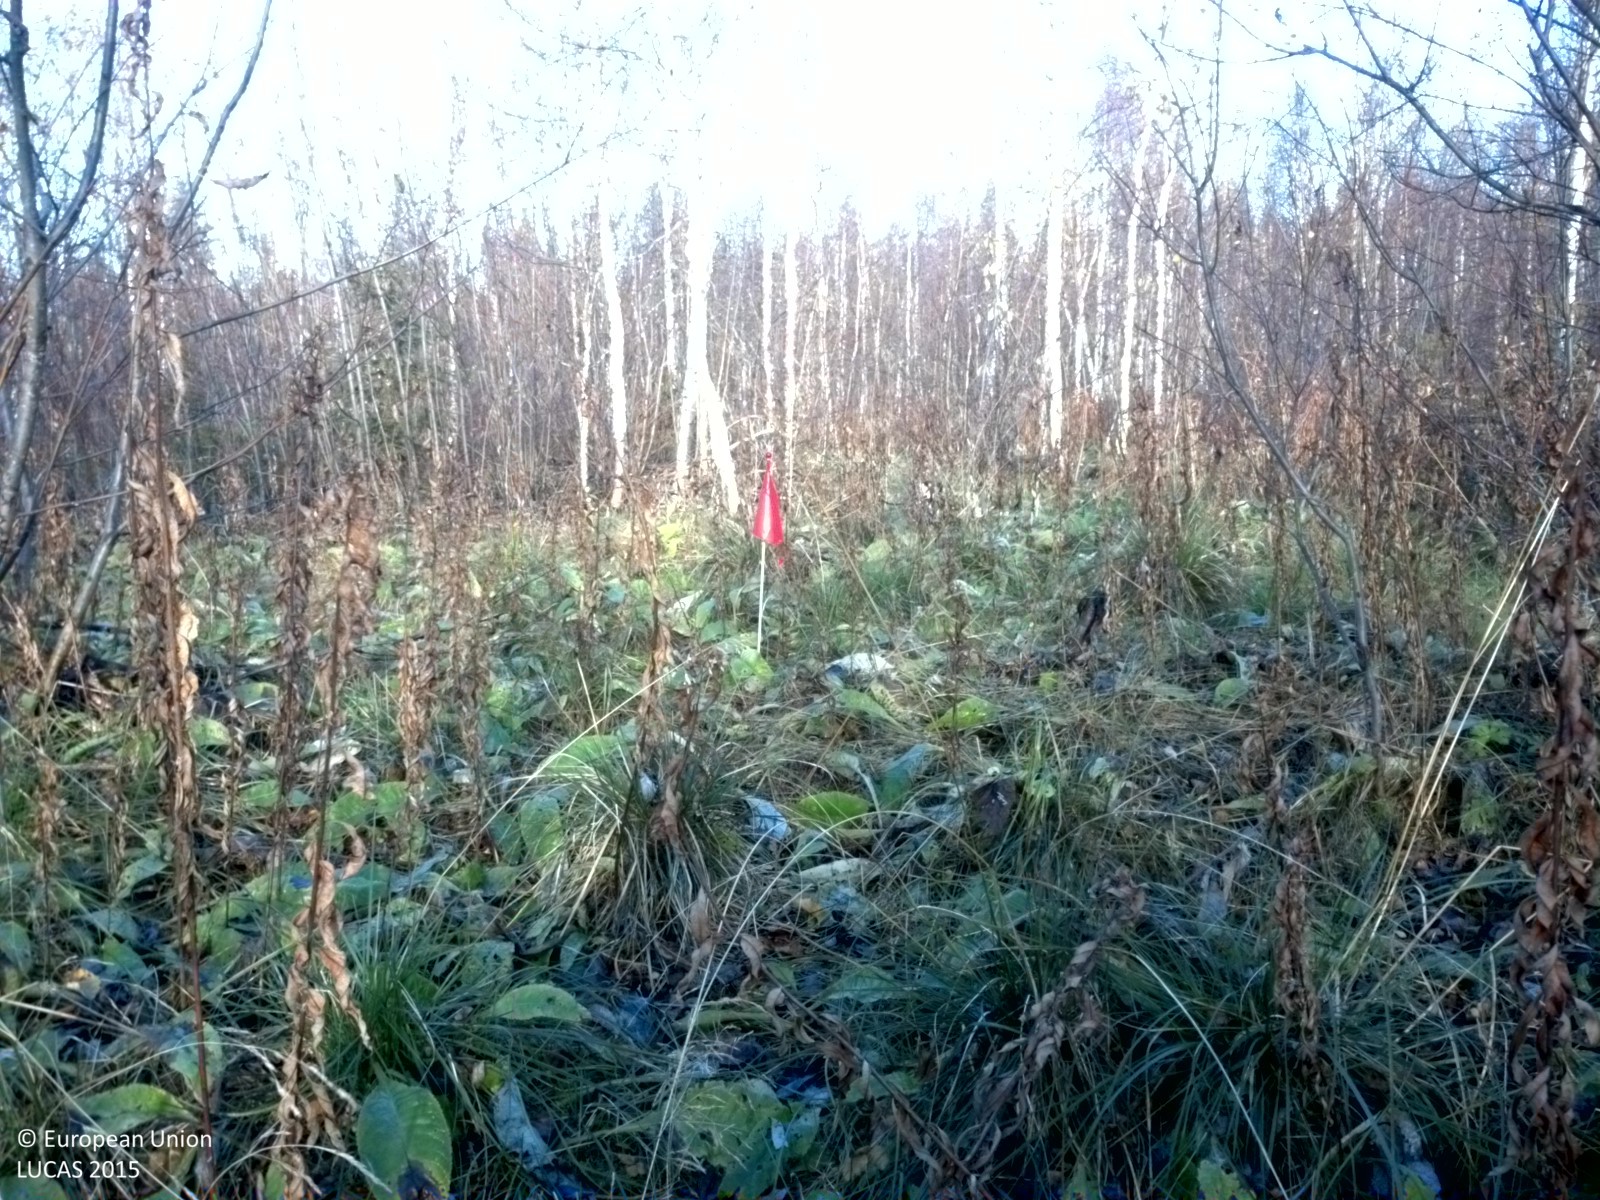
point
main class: Woodland
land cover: Broadleaved woodland
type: non-riverine alder, birch or aspen forest
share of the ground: 50 - 75 %
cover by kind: broadleaved forest trees 55 %, herbaceous plants 35 %, shrubs 10 %
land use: Forestry
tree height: > 5 m
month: October
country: SE
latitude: 65.7412
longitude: 21.4226
